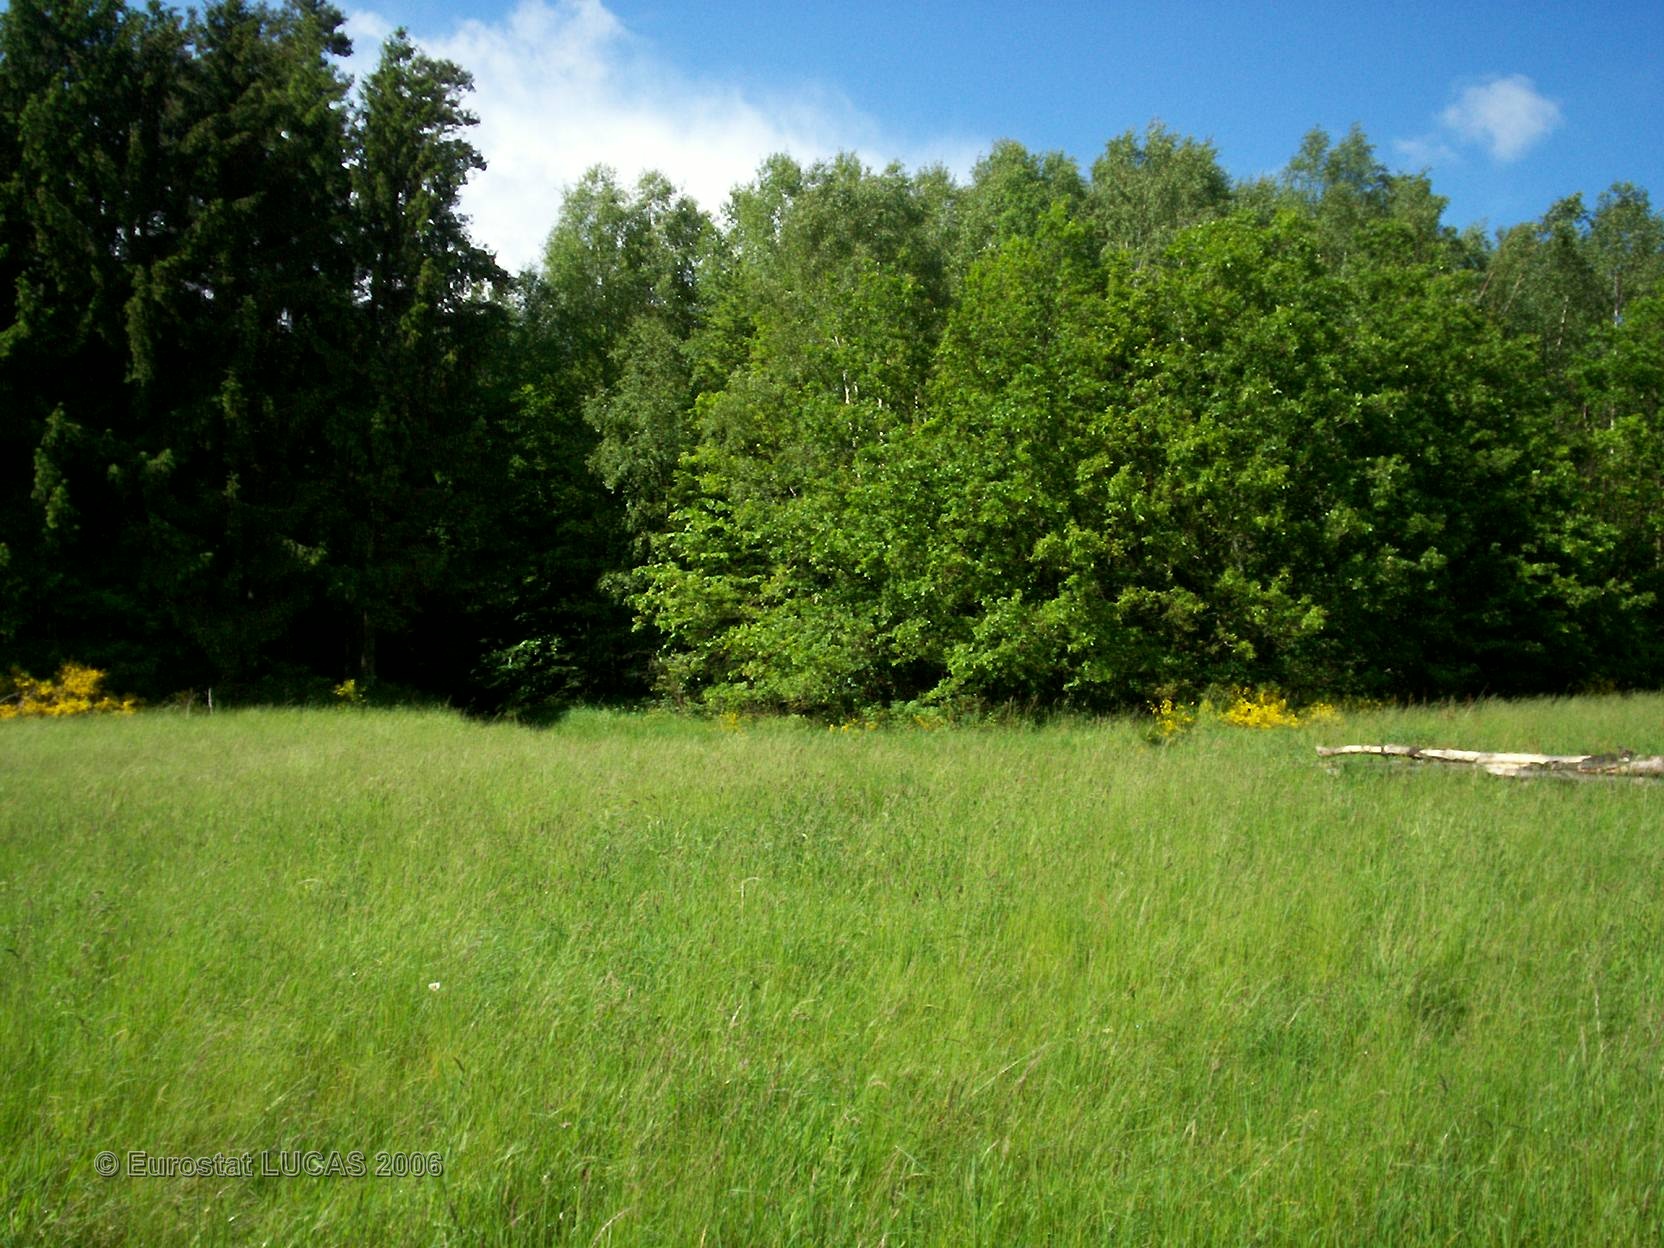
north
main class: Grassland
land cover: Grassland without tree/shrub cover
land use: Agriculture (excluding fallow land and kitchen gardens)
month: May
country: FR
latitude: 48.2921
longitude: 7.0491
